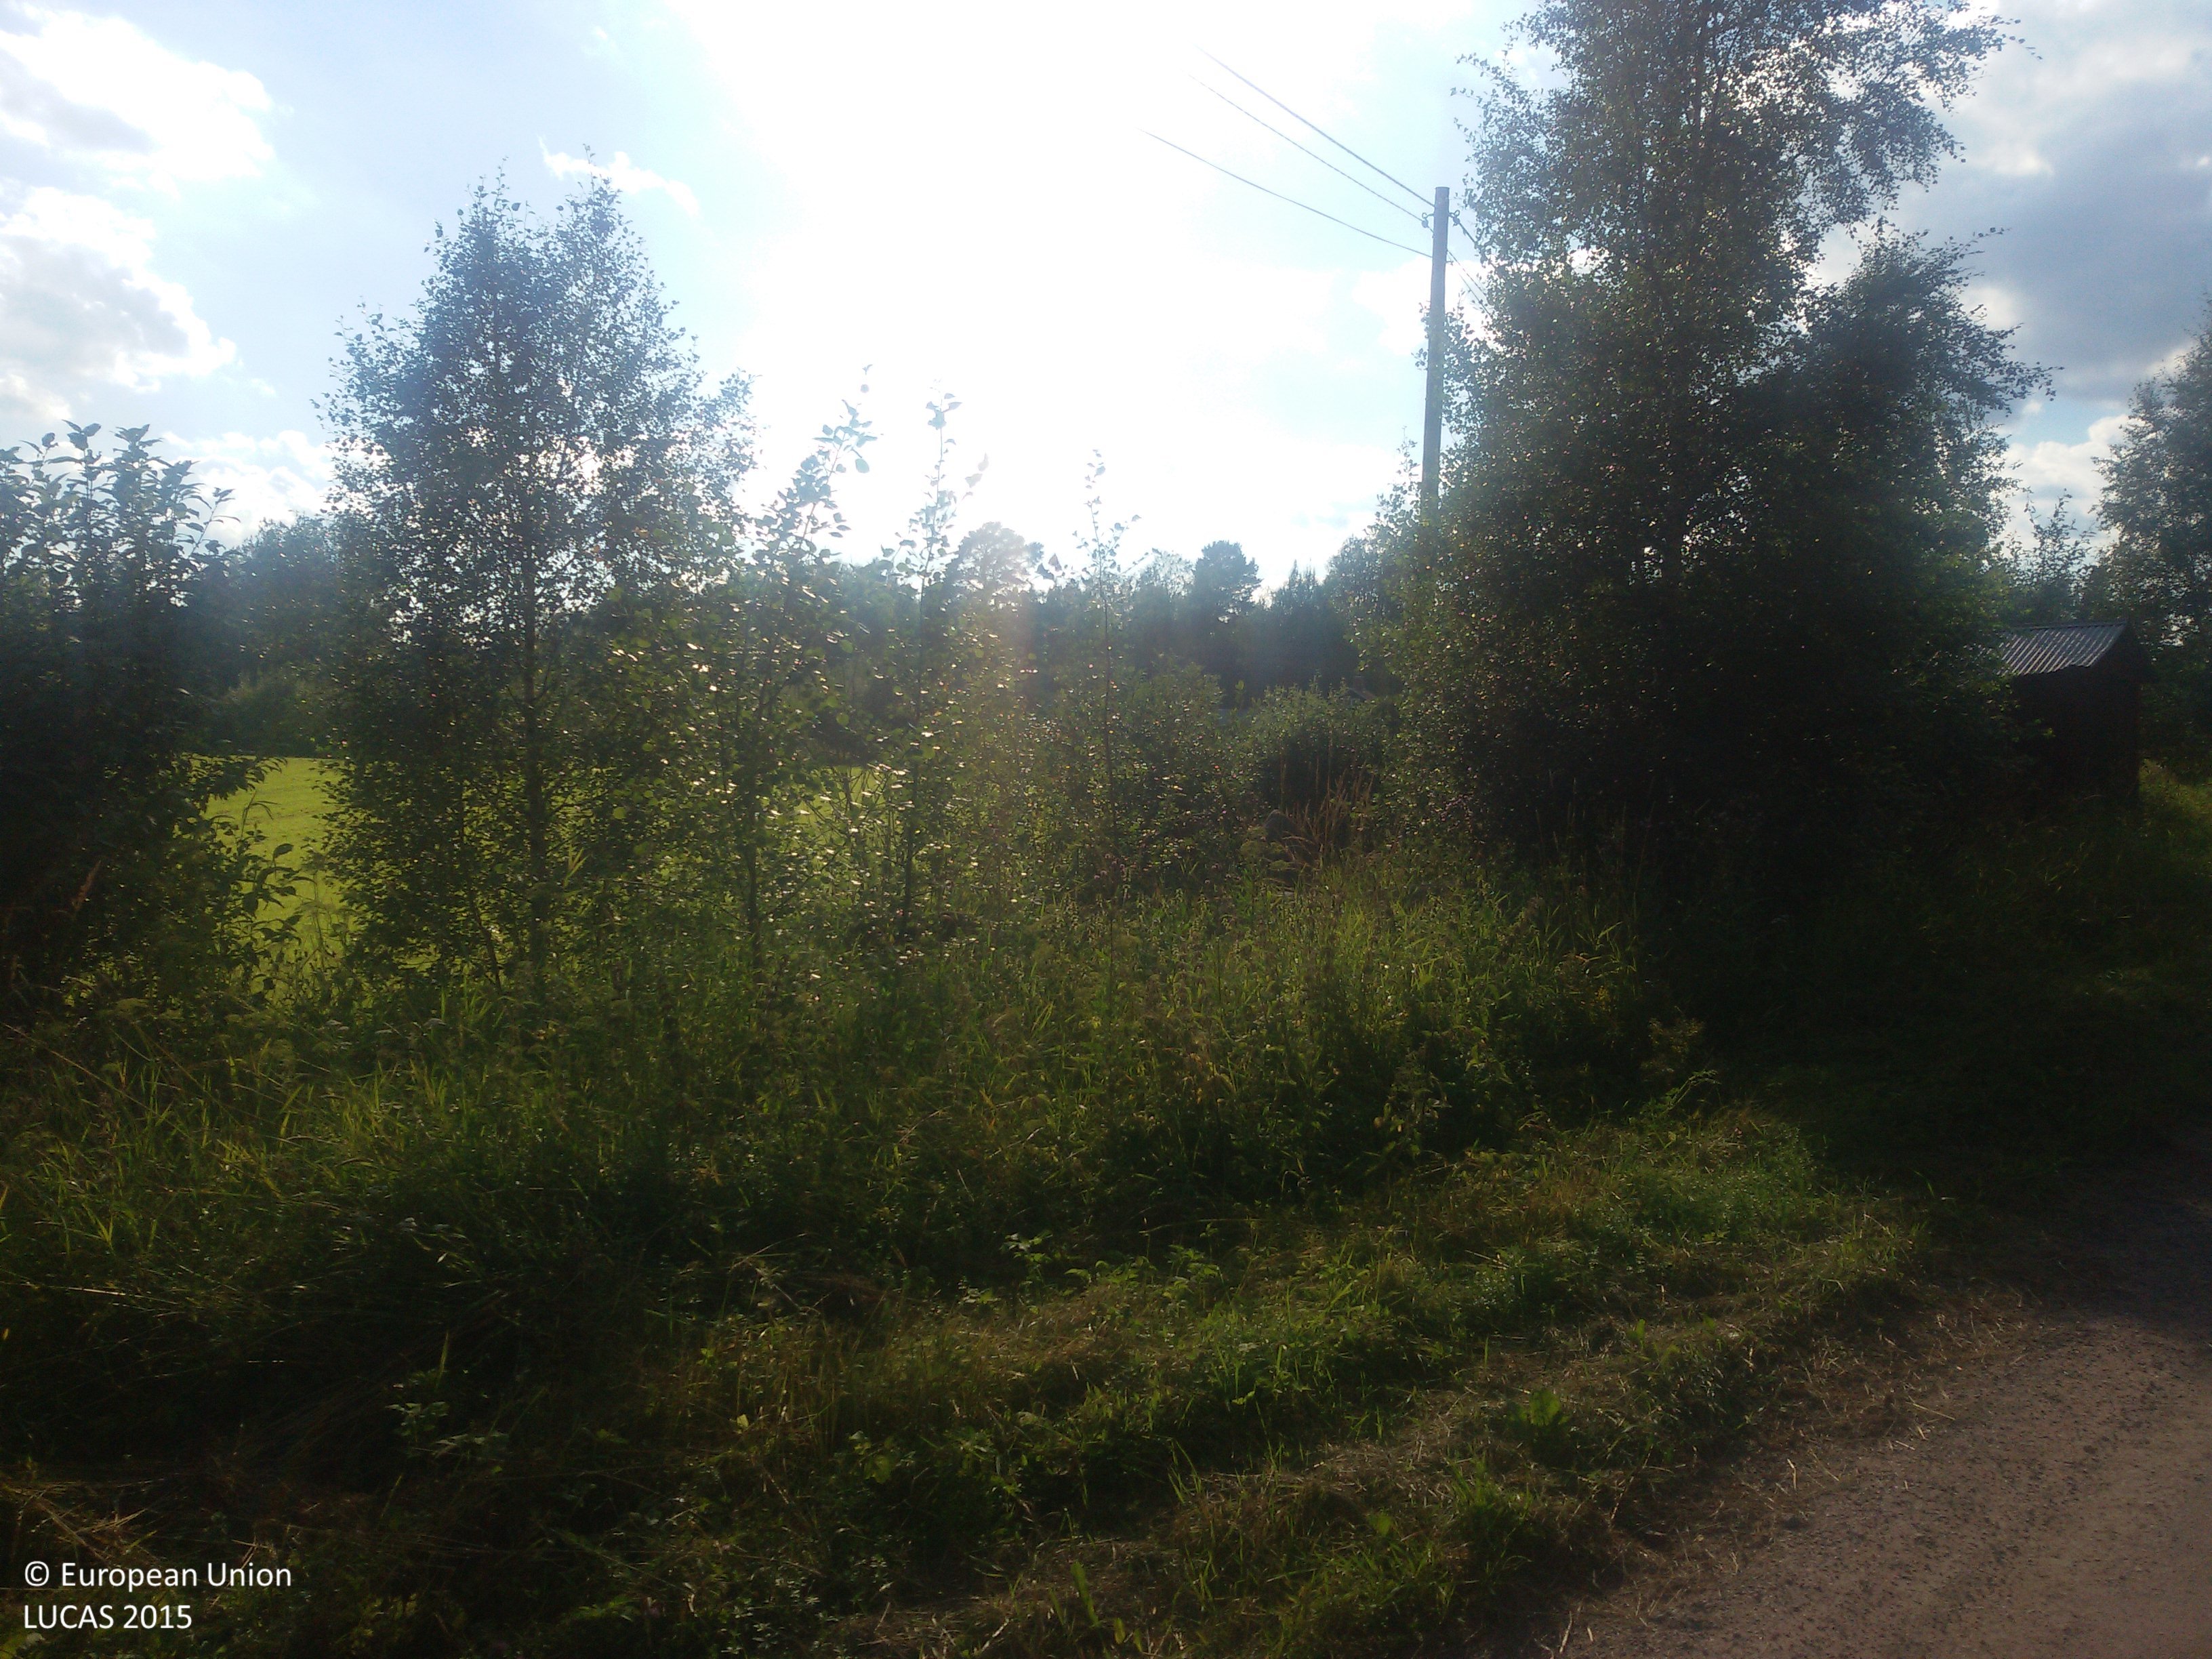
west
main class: Grassland
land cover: Grassland with sparse tree/shrub cover
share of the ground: > 75 %
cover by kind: herbaceous plants 95 %, broadleaved forest trees 5 %
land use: Residential
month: August
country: SE
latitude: 60.6020
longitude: 16.6543
